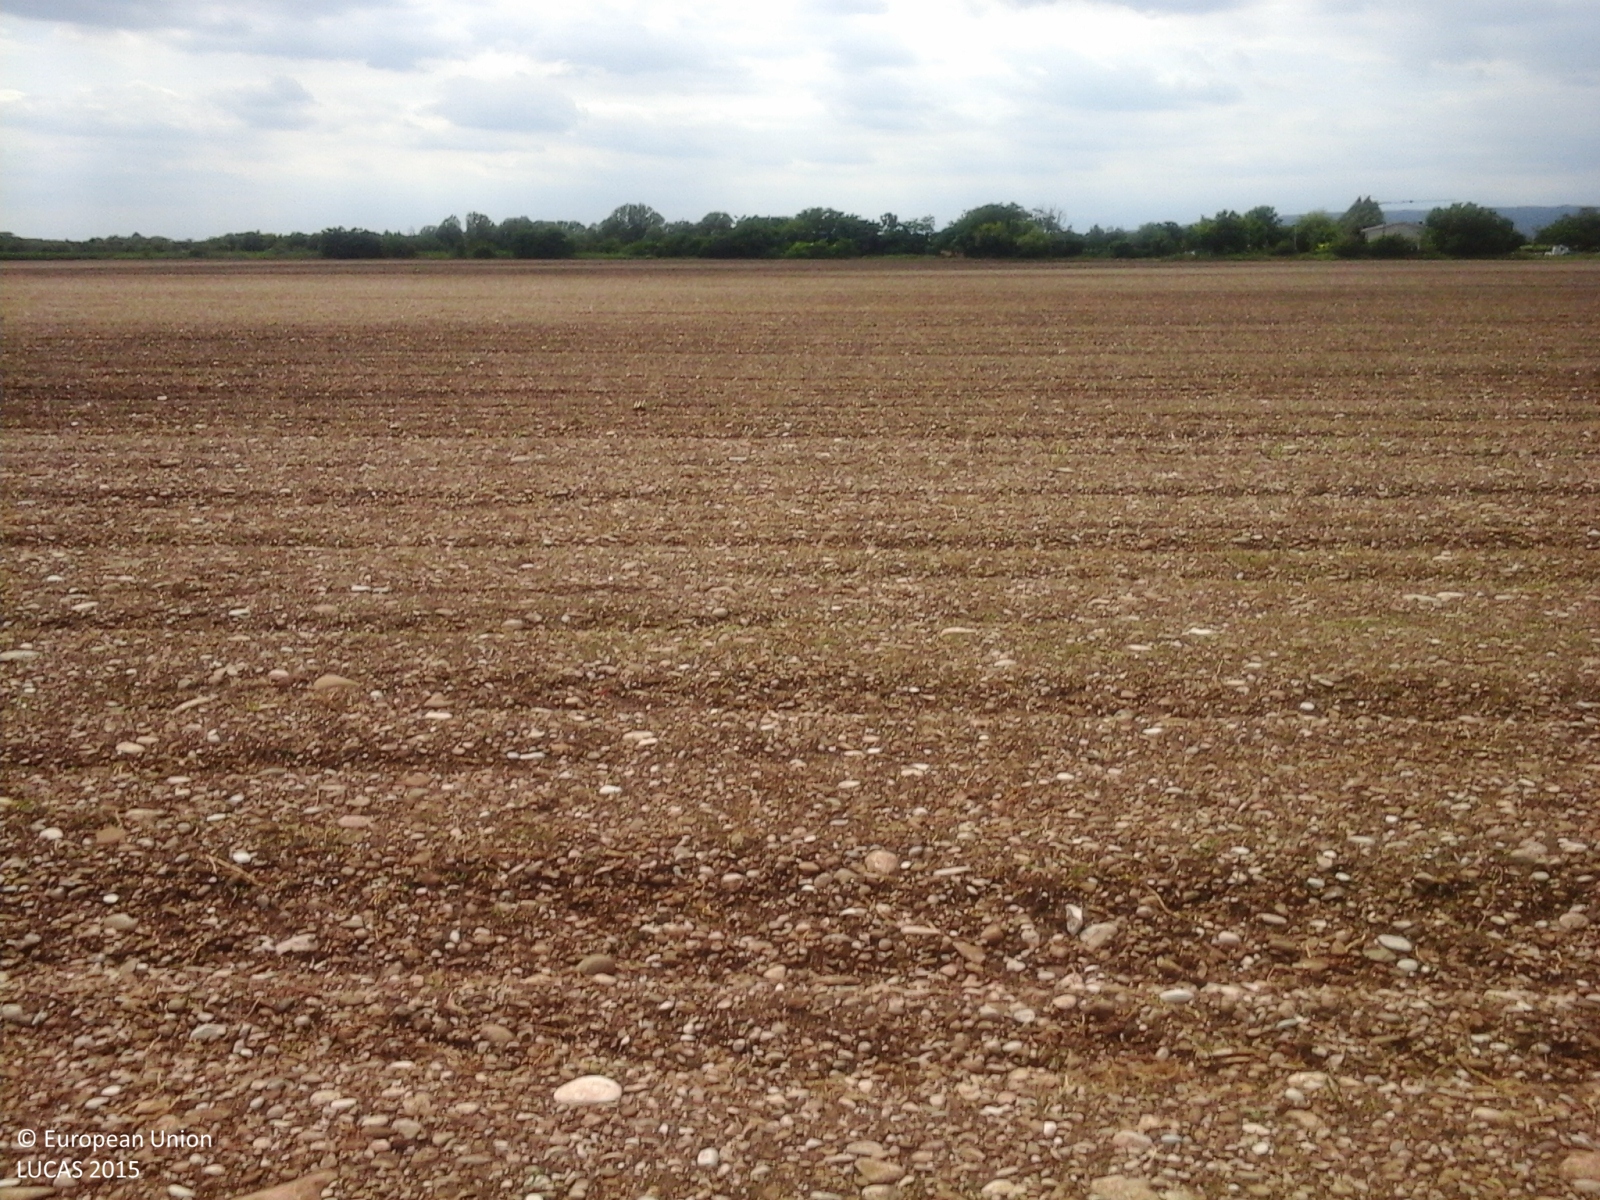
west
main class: Cropland
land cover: Common wheat
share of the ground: < 10 %
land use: Agriculture (excluding fallow land and kitchen gardens)
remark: Harvested field
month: June
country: IT
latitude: 45.7695
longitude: 12.2215
